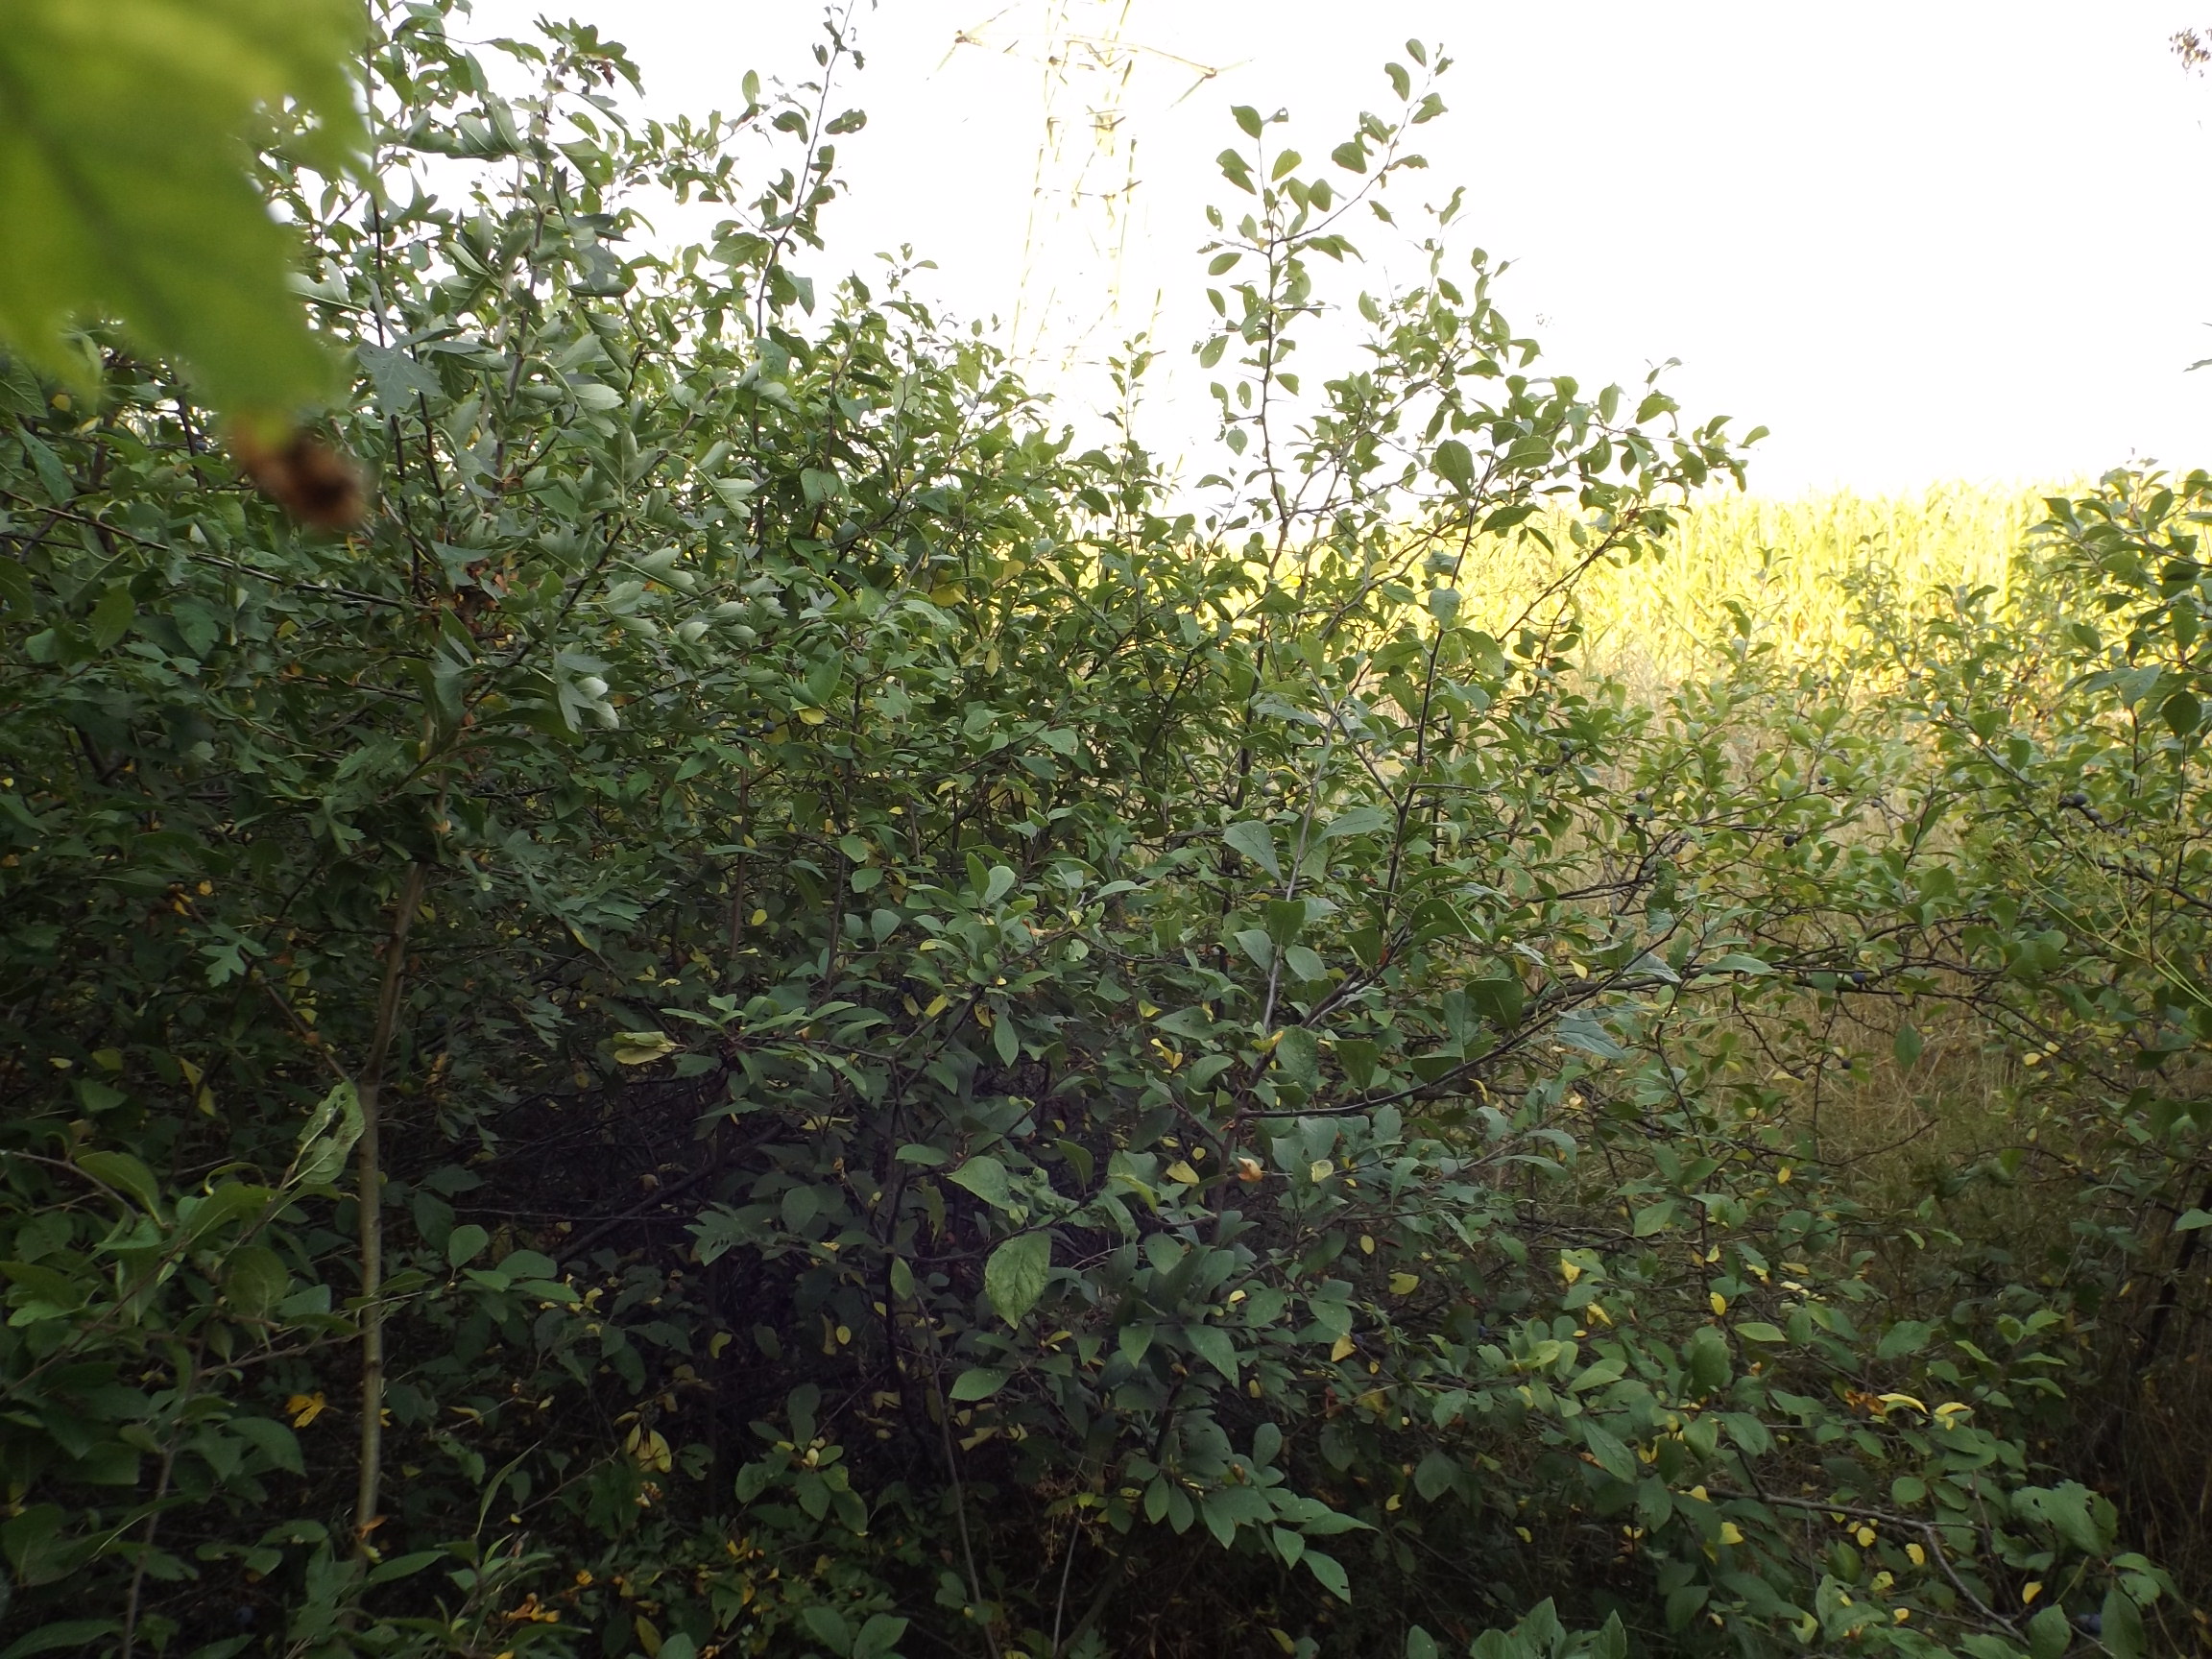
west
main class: Woodland
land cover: Broadleaved woodland
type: beech forest
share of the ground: 50 - 75 %
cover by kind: broadleaved forest trees 70 %, shrubs 20 %, herbaceous plants 10 %
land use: Forestry
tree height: > 5 m
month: July
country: BG
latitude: 43.4721
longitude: 27.6262
